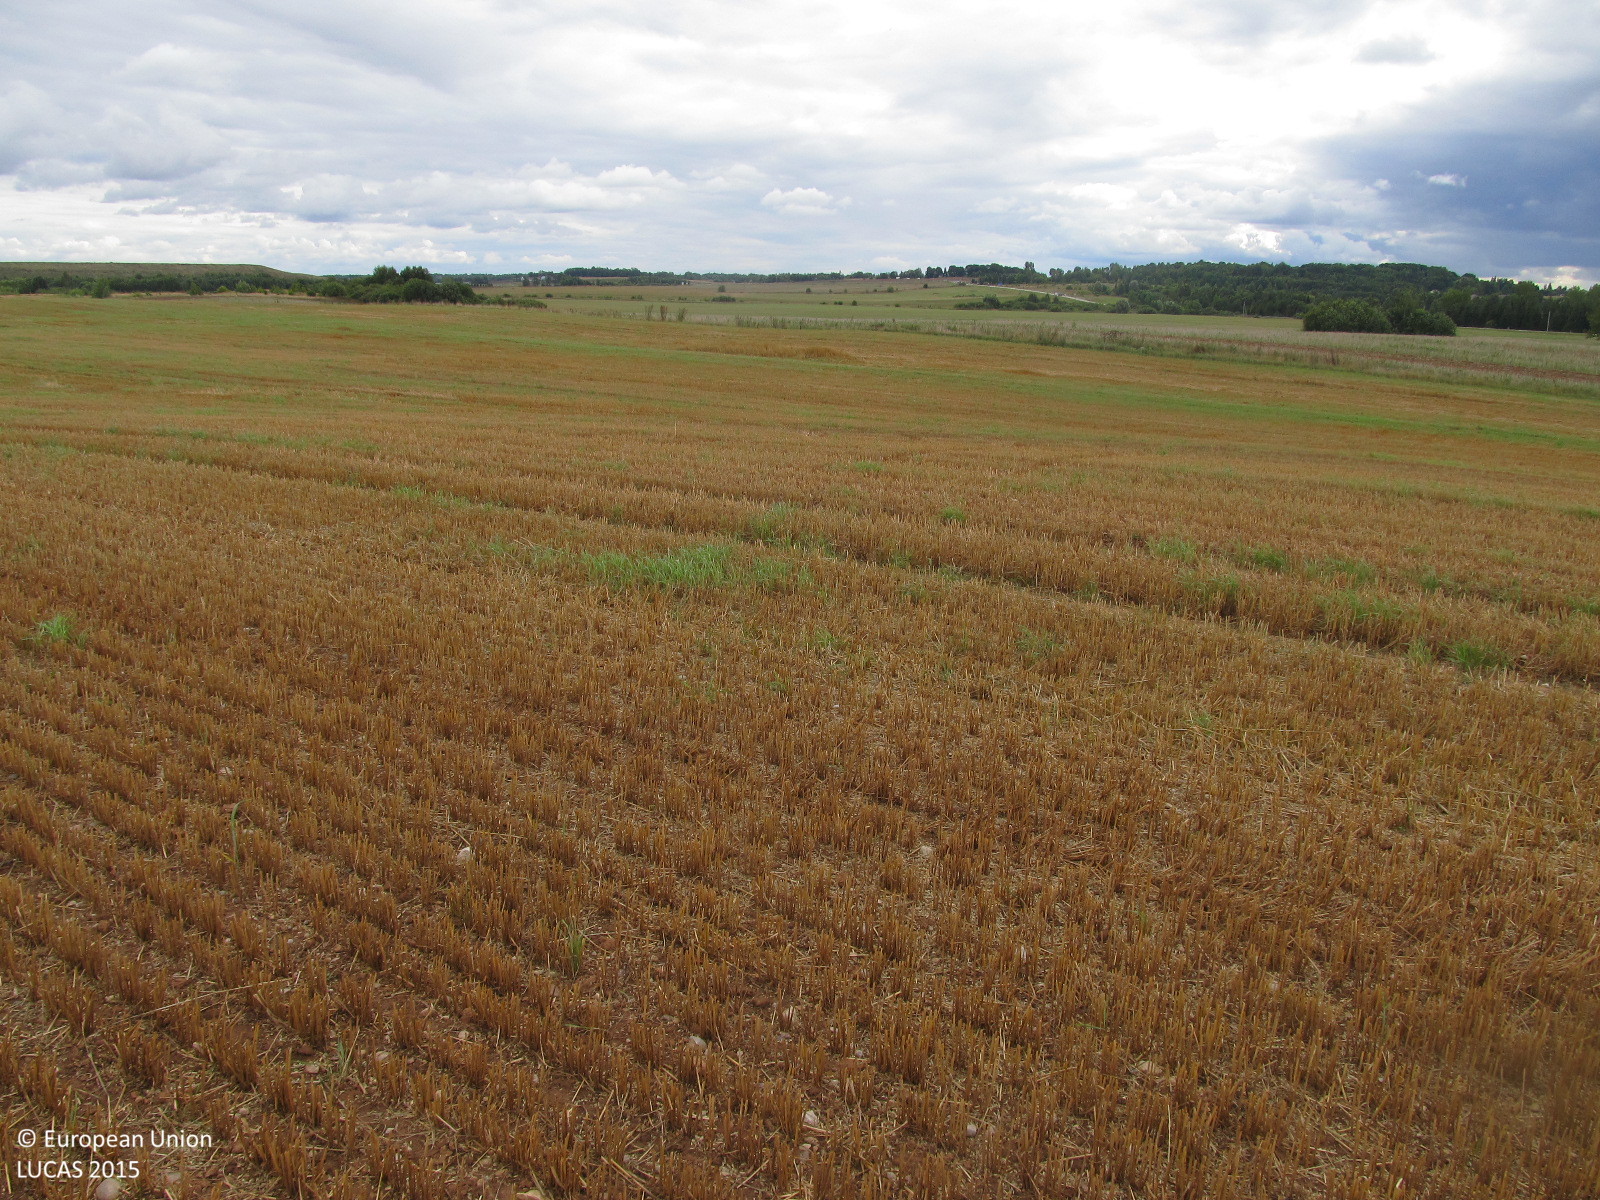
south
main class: Cropland
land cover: Common wheat
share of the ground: 50 - 75 %
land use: Agriculture (excluding fallow land and kitchen gardens)
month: September
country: LT
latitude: 55.9393
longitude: 23.3791
